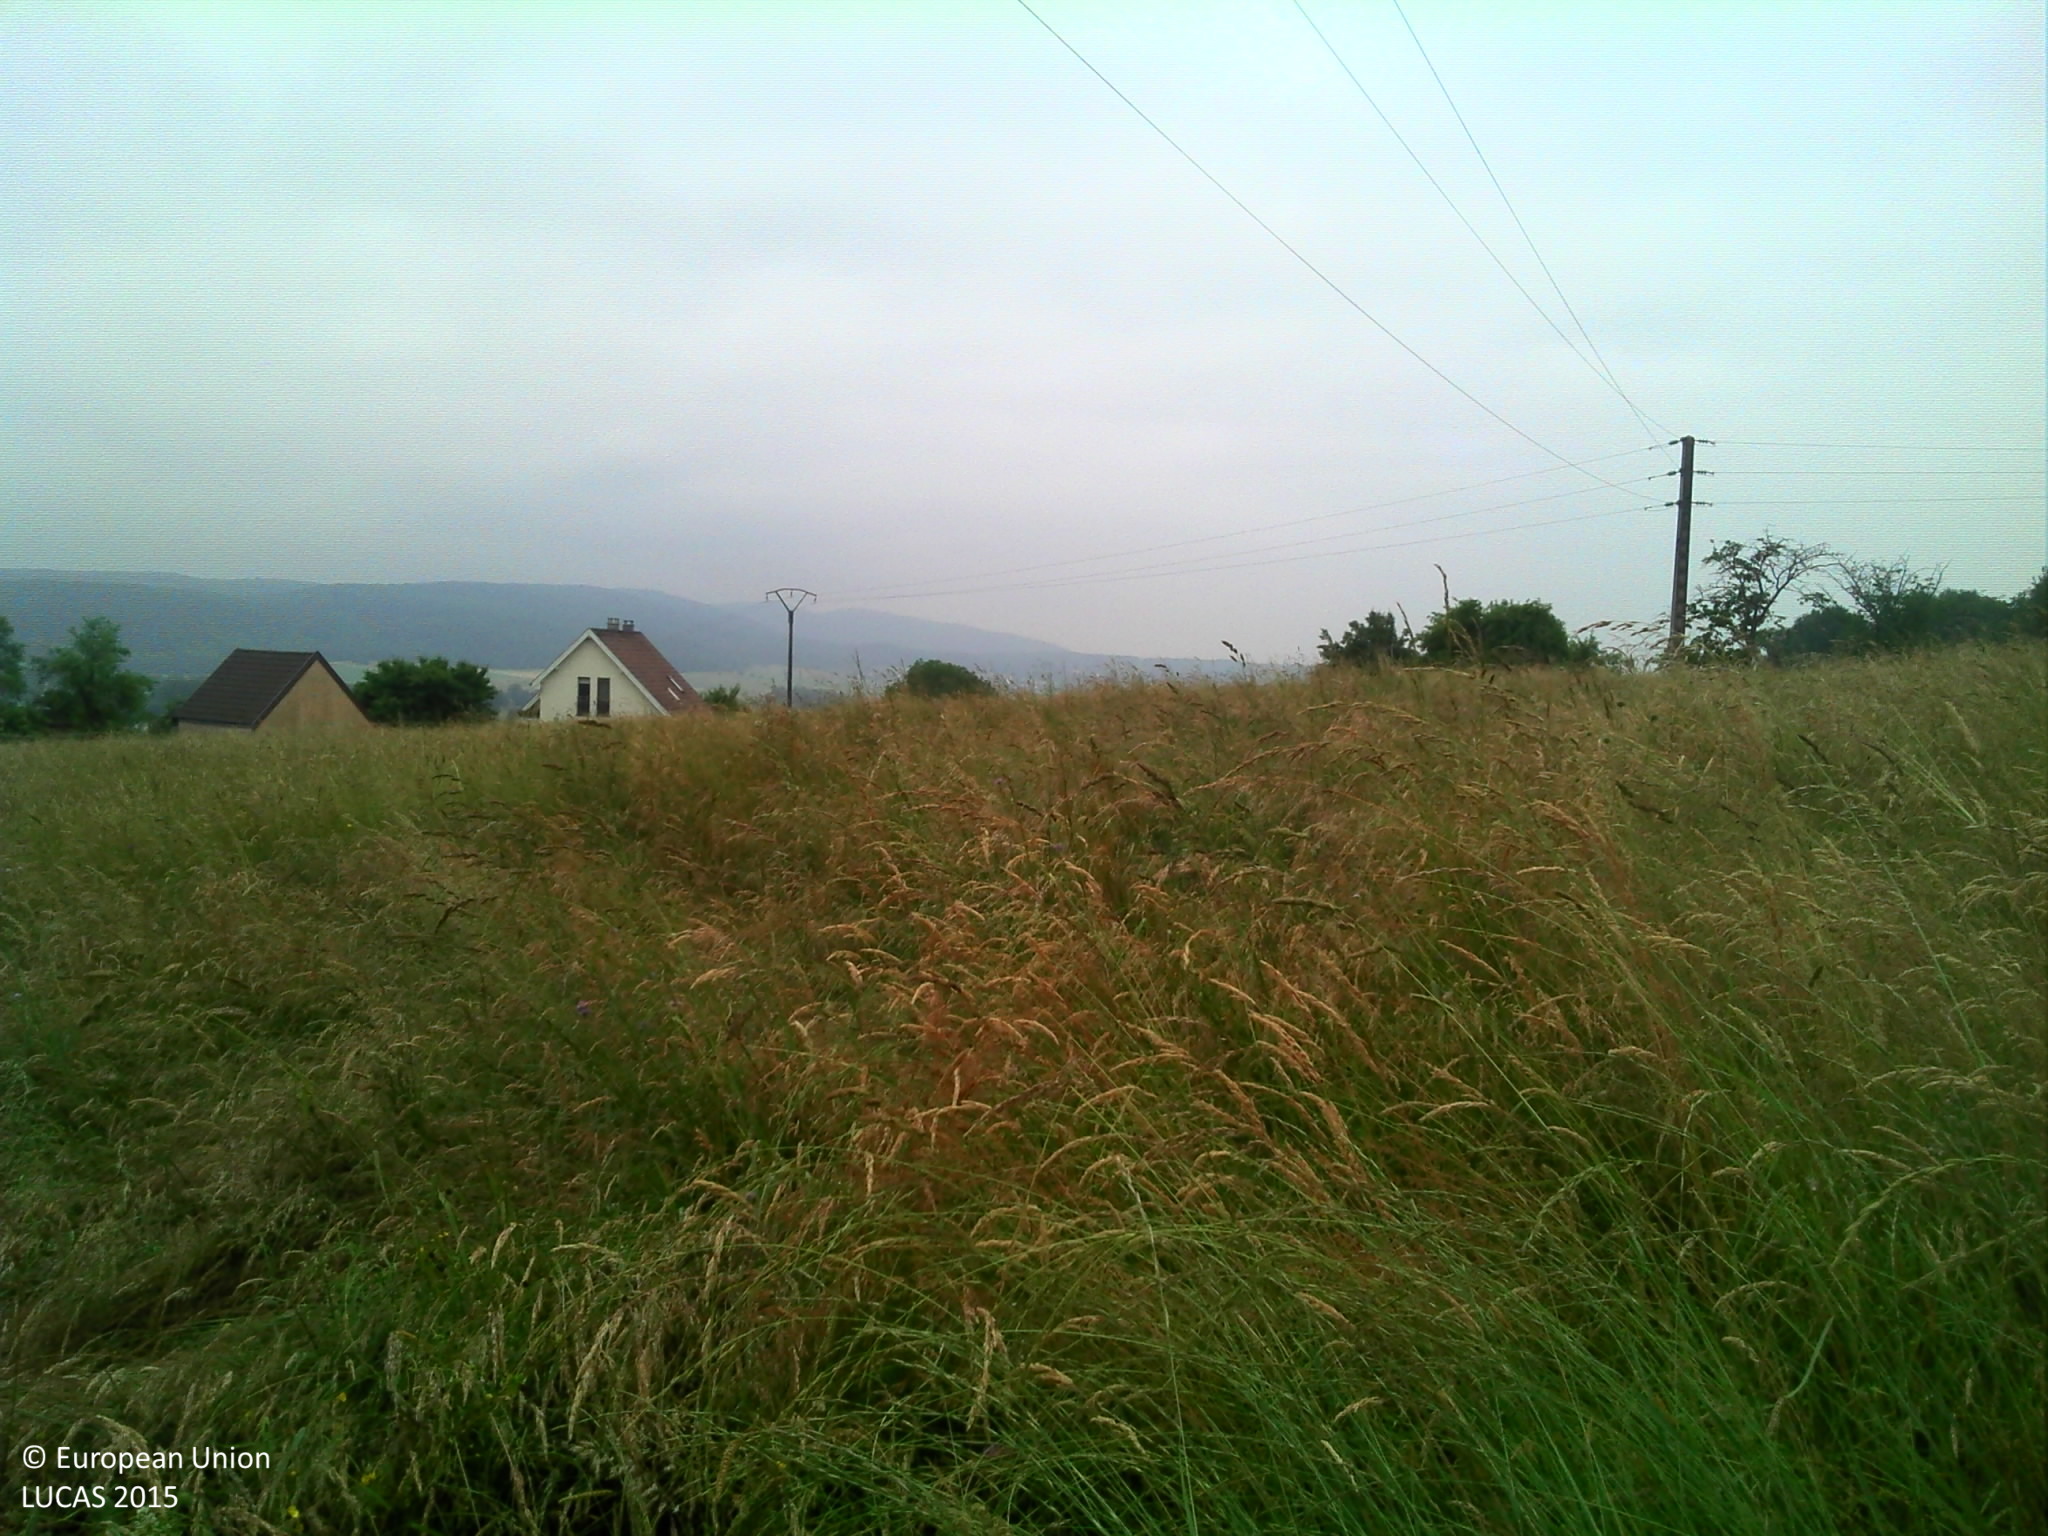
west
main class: Grassland
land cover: Grassland with sparse tree/shrub cover
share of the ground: > 75 %
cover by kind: herbaceous plants 95 %, broadleaved forest trees 5 %
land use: Agriculture (excluding fallow land and kitchen gardens)
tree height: > 5 m
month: June
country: FR
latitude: 47.5089
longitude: 7.4126
